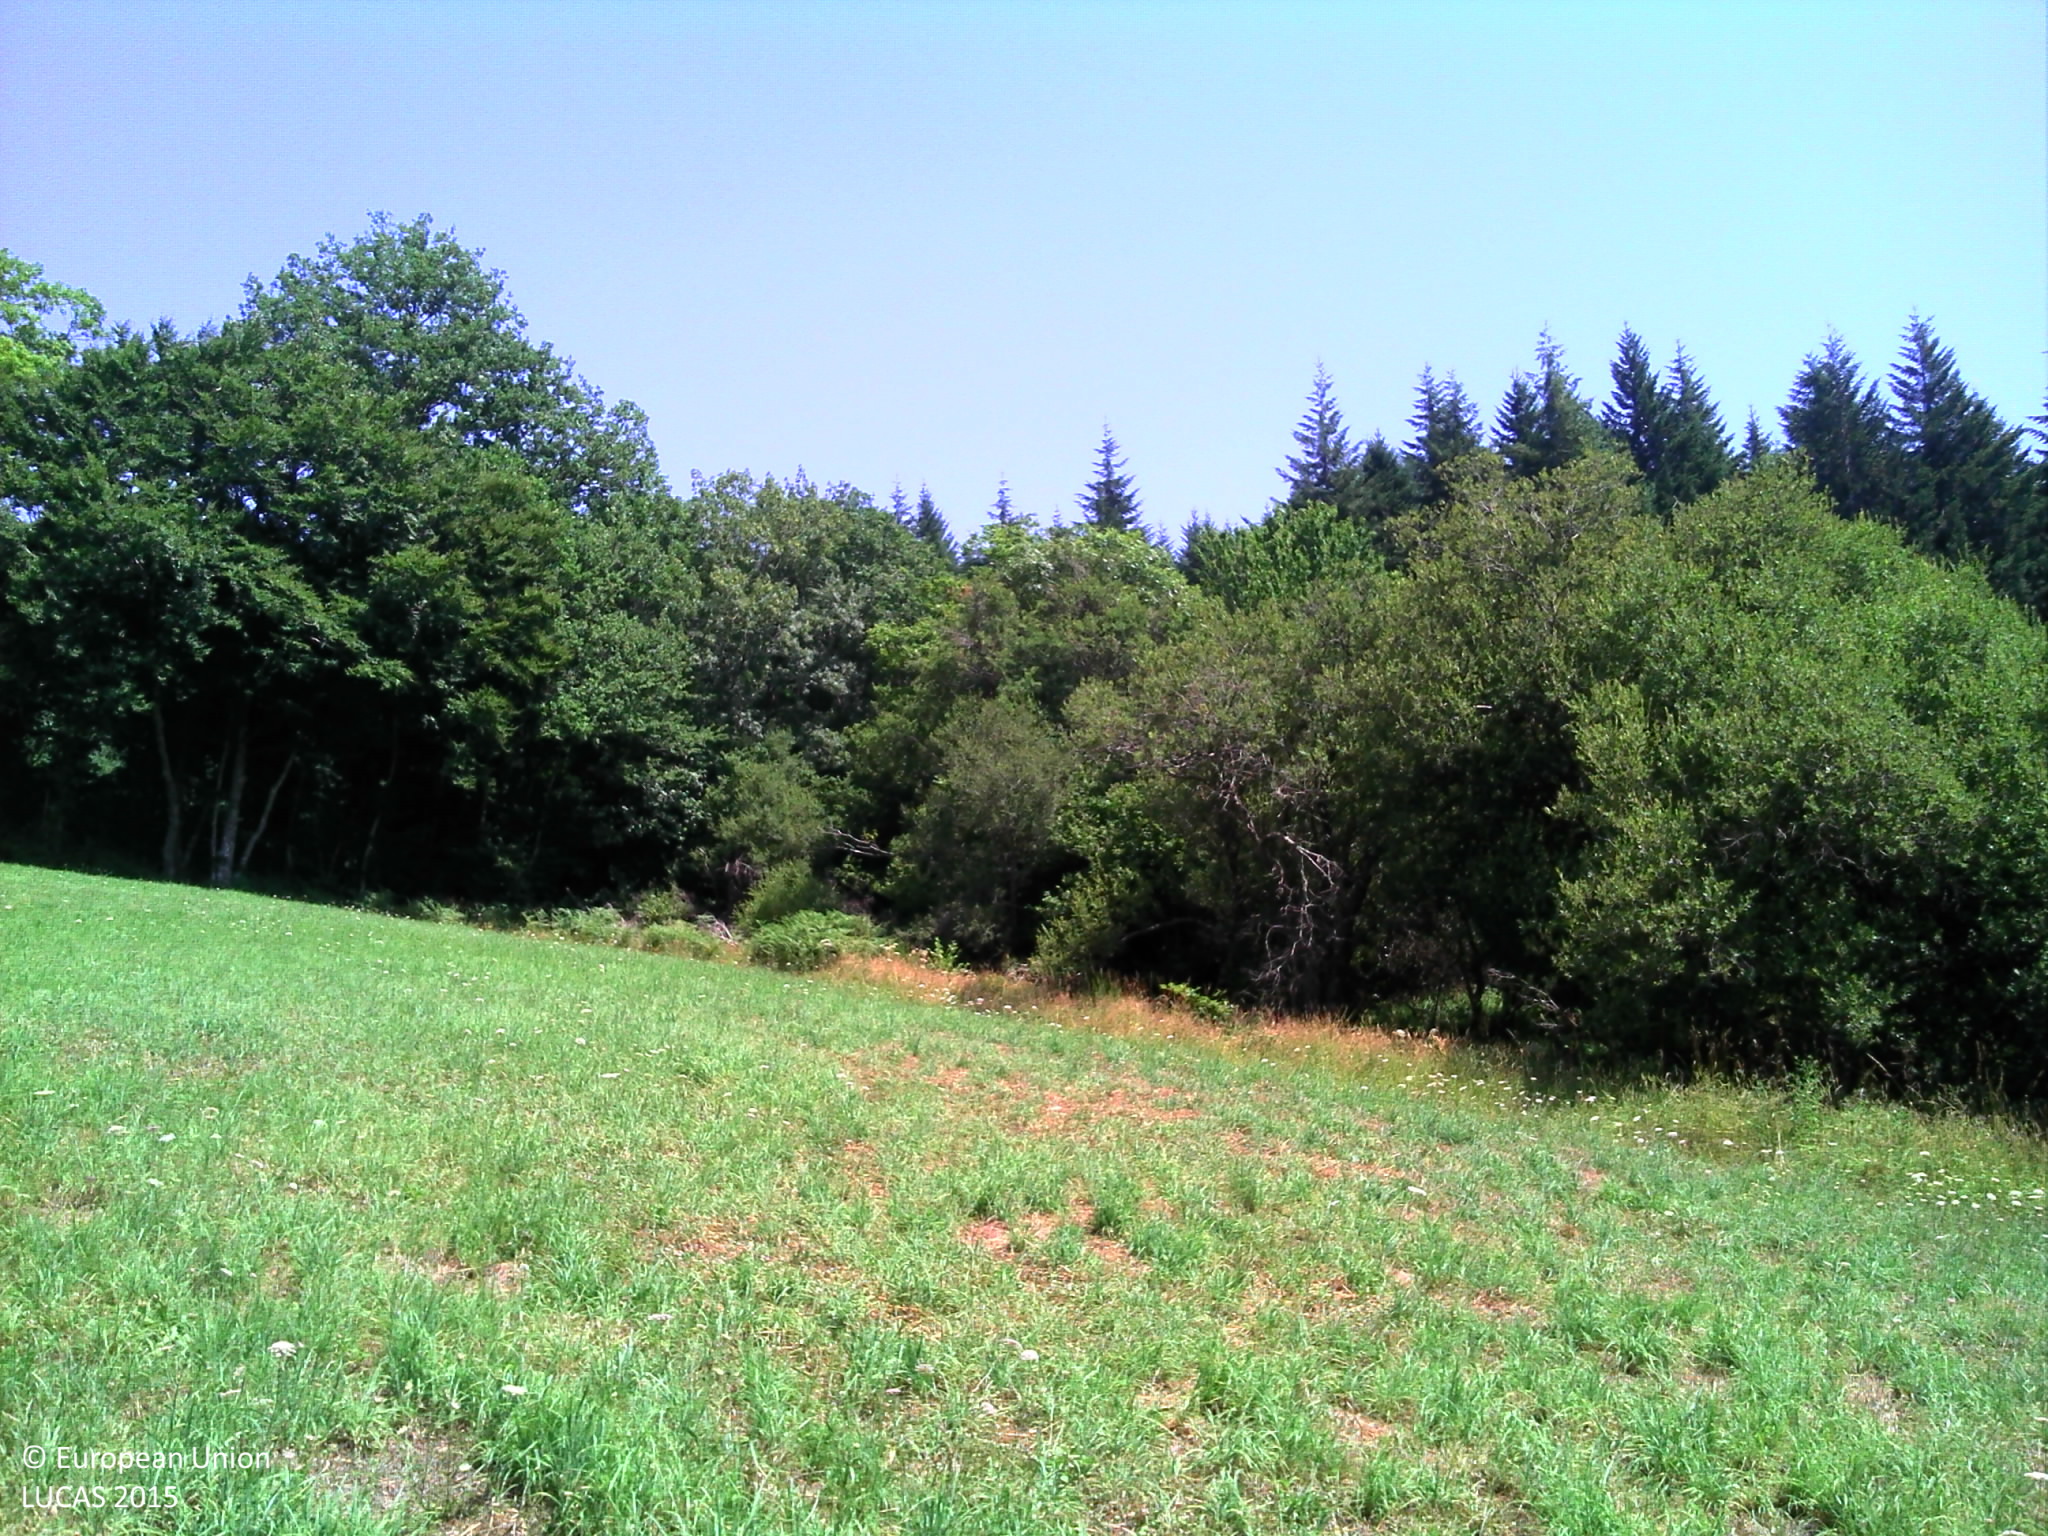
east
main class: Grassland
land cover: Grassland without tree/shrub cover
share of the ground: > 75 %
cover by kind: herbaceous plants 100 %
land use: Agriculture (excluding fallow land and kitchen gardens)
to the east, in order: Grassland without tree/shrub cover; Broadleaved woodland; Fences; Tracks; Grass margins; Ditches and canals; Shrubland with sparse tree cover; Spruce dominated coniferous woodland; Ditches and canals; Spruce dominated coniferous woodland; Tracks; Spruce dominated coniferous woodland
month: July
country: FR
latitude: 43.6554
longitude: 2.6539
